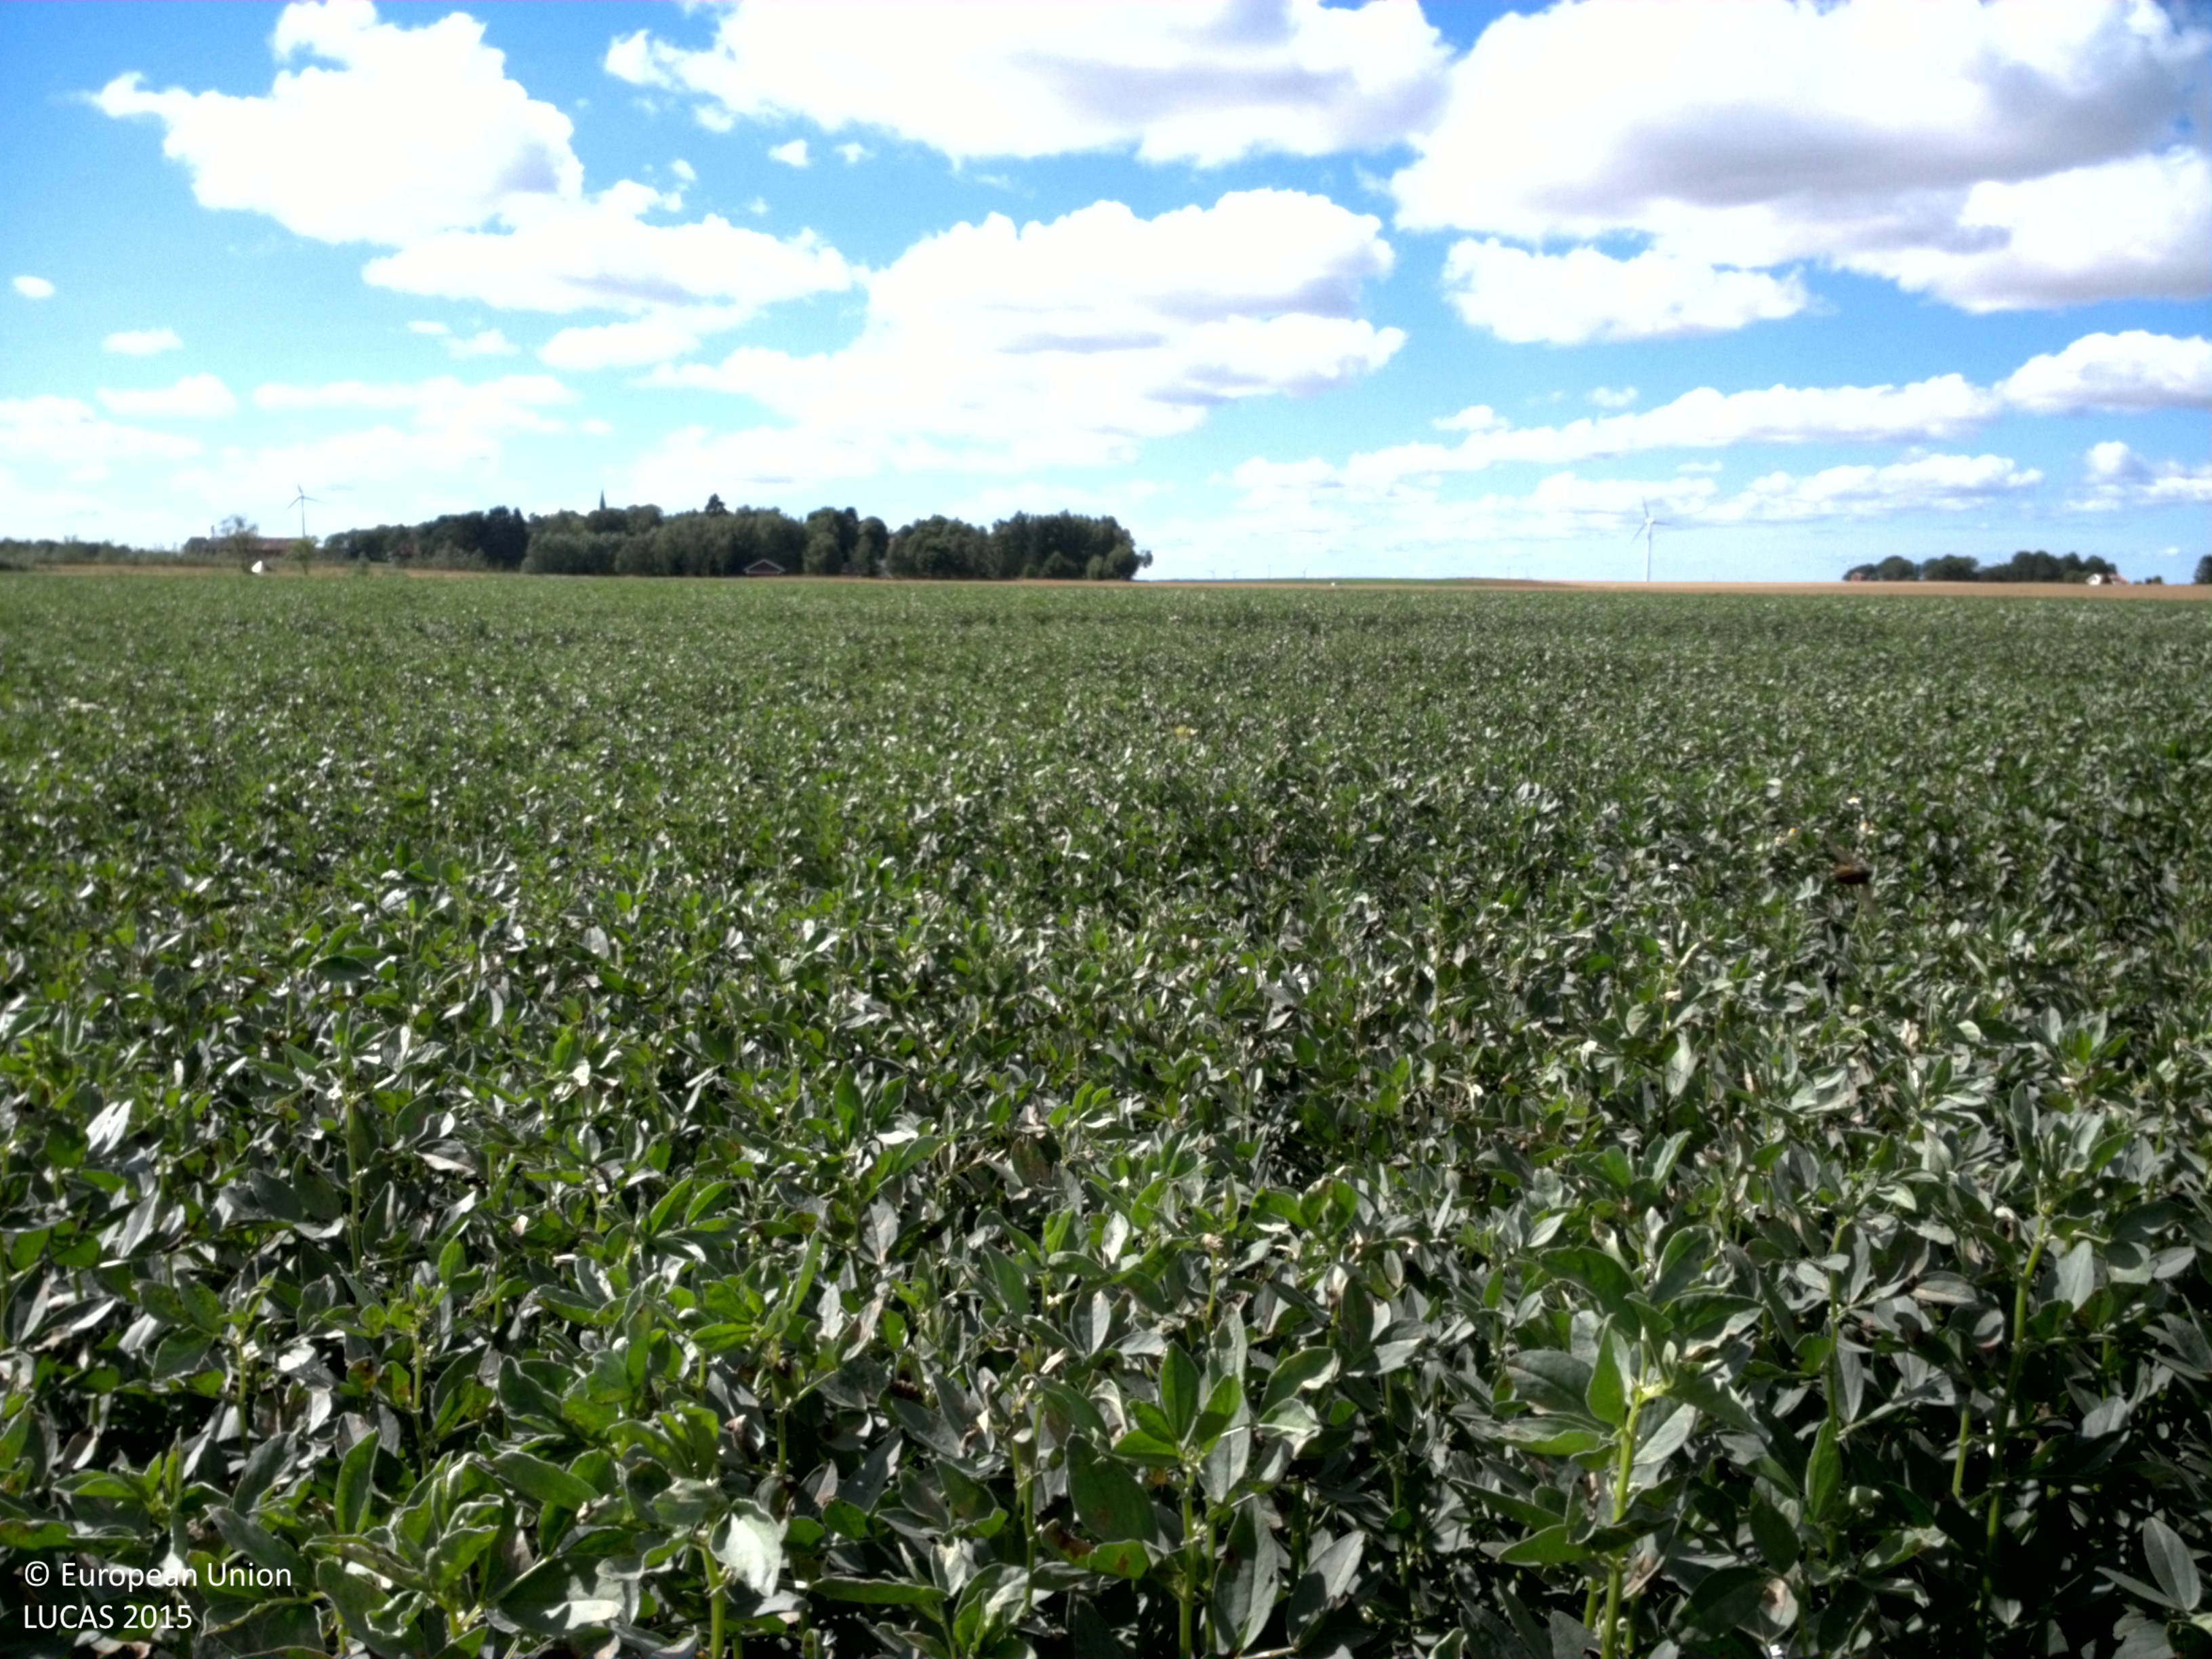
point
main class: Cropland
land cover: Dry pulses
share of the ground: > 75 %
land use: Agriculture (excluding fallow land and kitchen gardens)
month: August
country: SE
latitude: 58.2694
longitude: 13.2846
